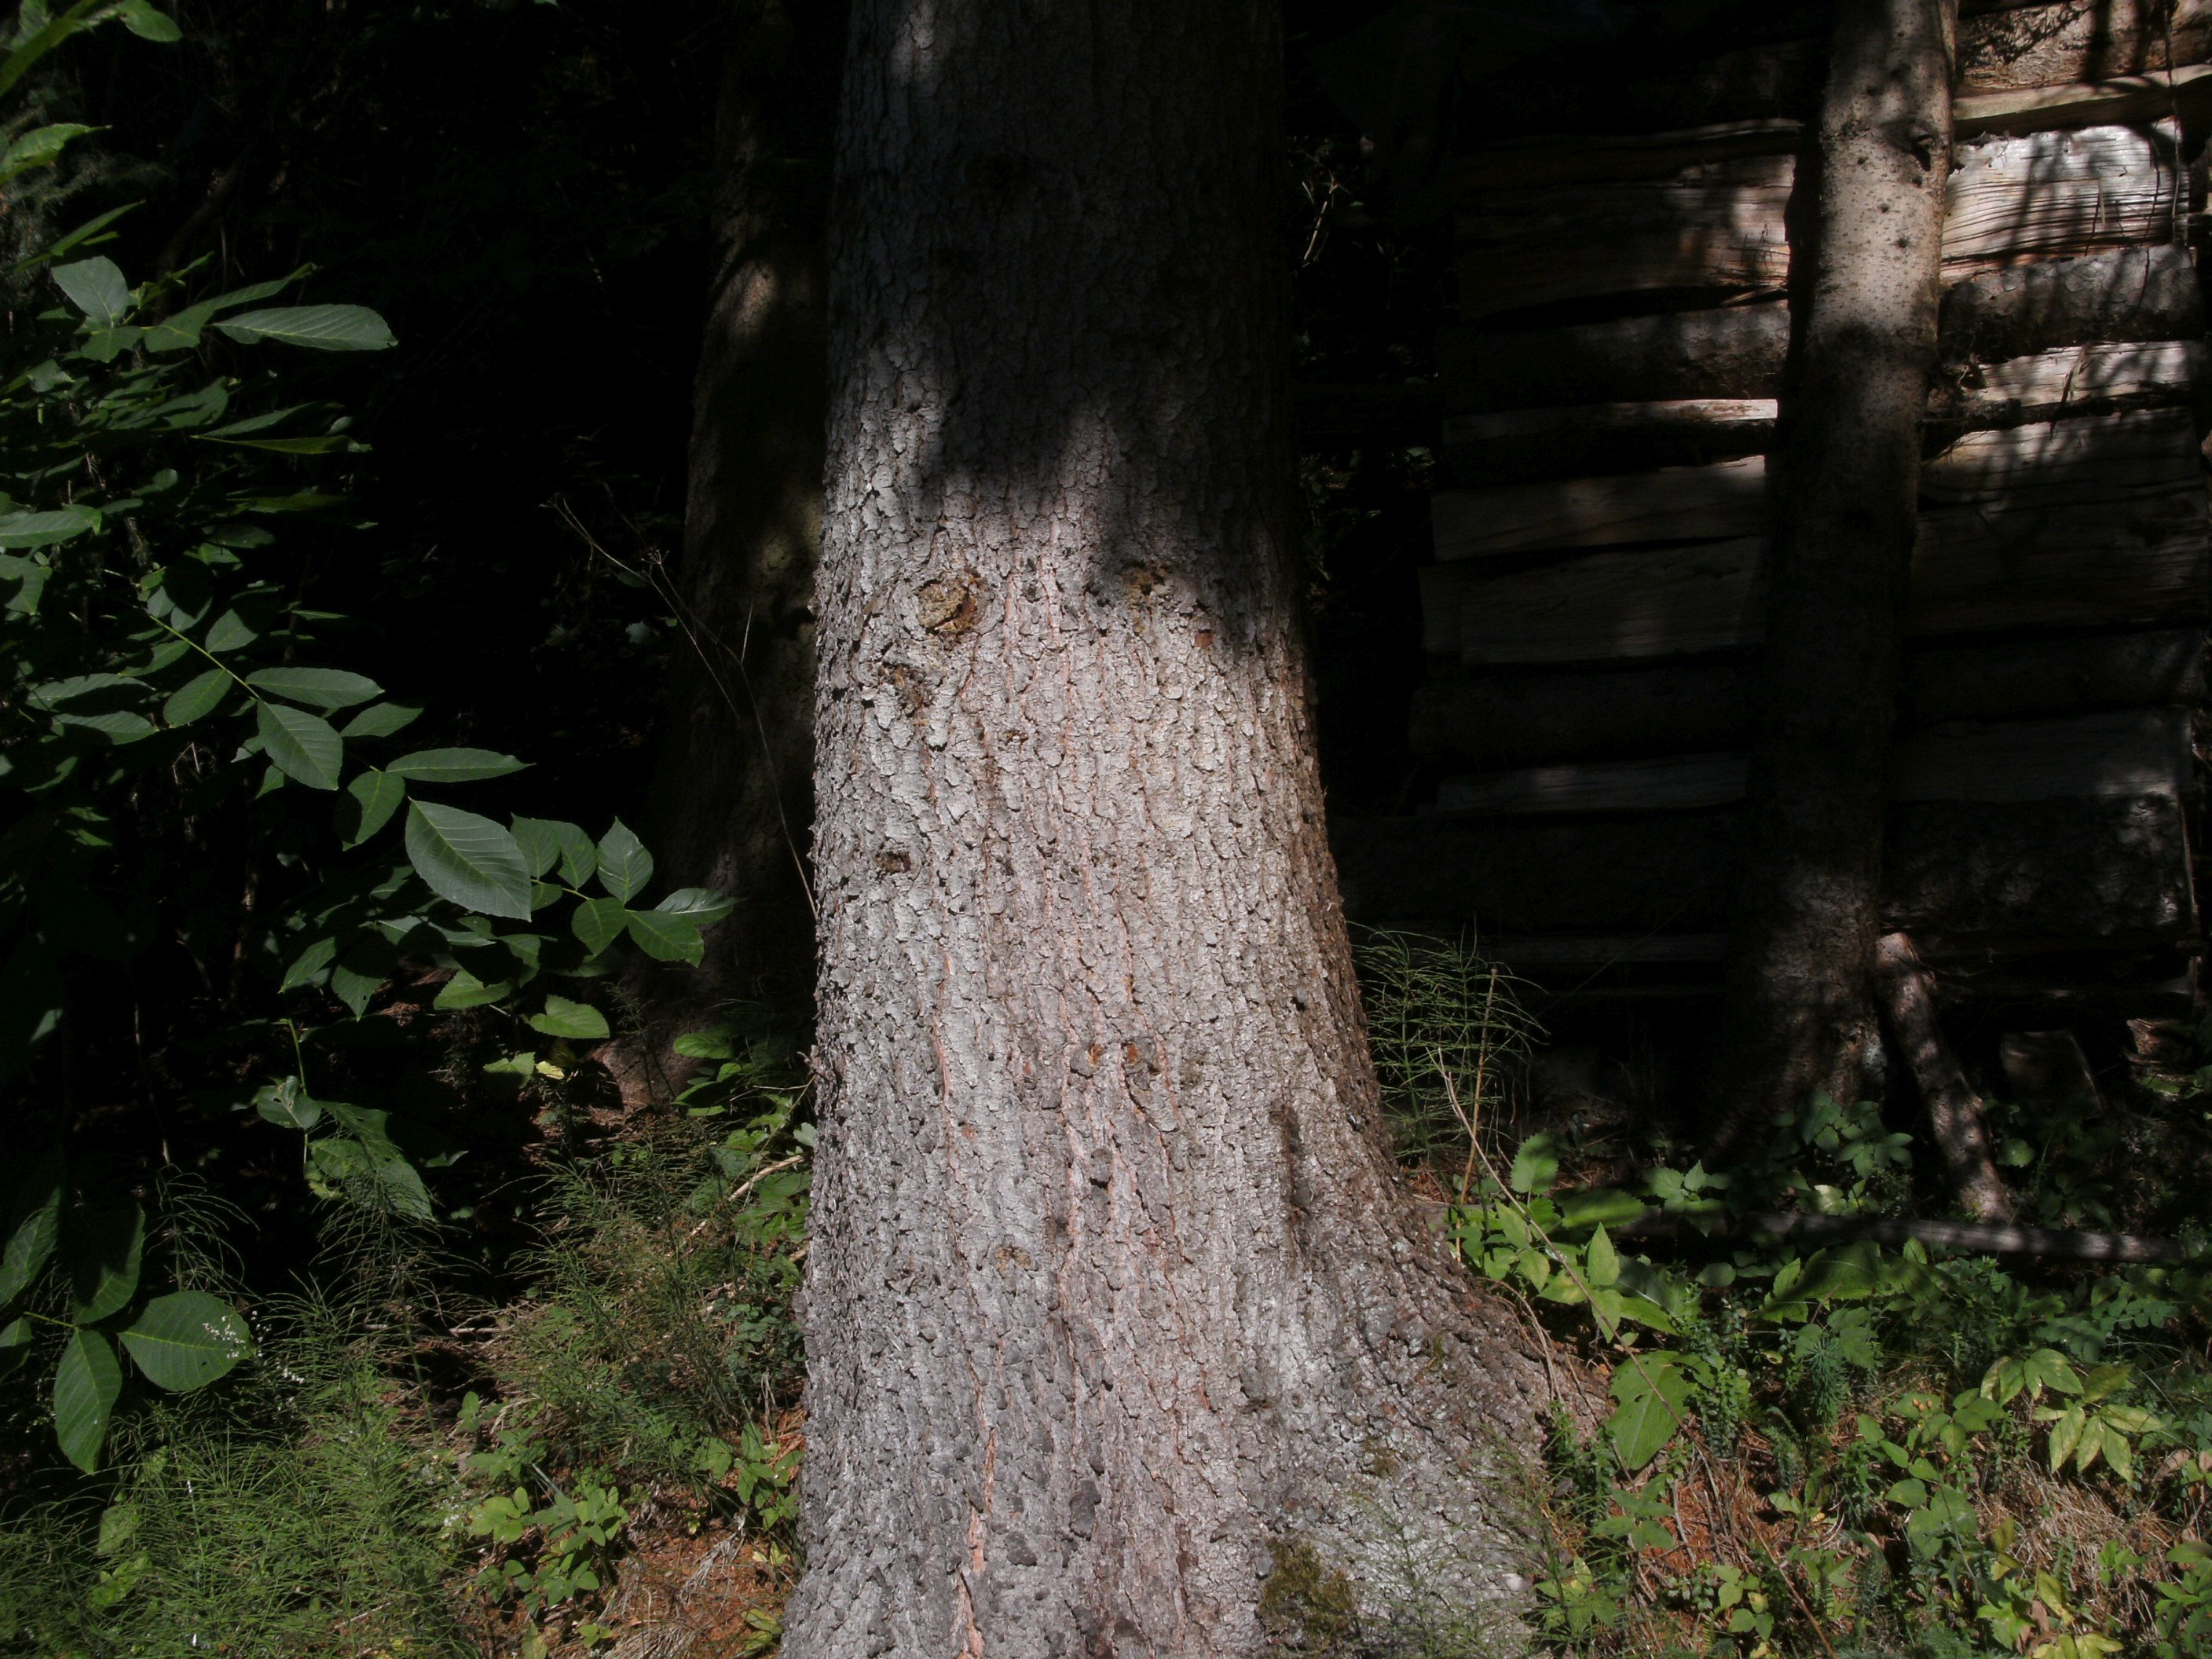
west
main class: Woodland
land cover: Spruce dominated coniferous woodland
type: alpine coniferous forest
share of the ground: > 75 %
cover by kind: coniferous forest trees 80 %, shrubs 10 %, herbaceous plants 5 %, unconsolidated bare surface 5 %
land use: Forestry
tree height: > 5 m
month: July
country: AT
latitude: 46.9090
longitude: 14.8431
